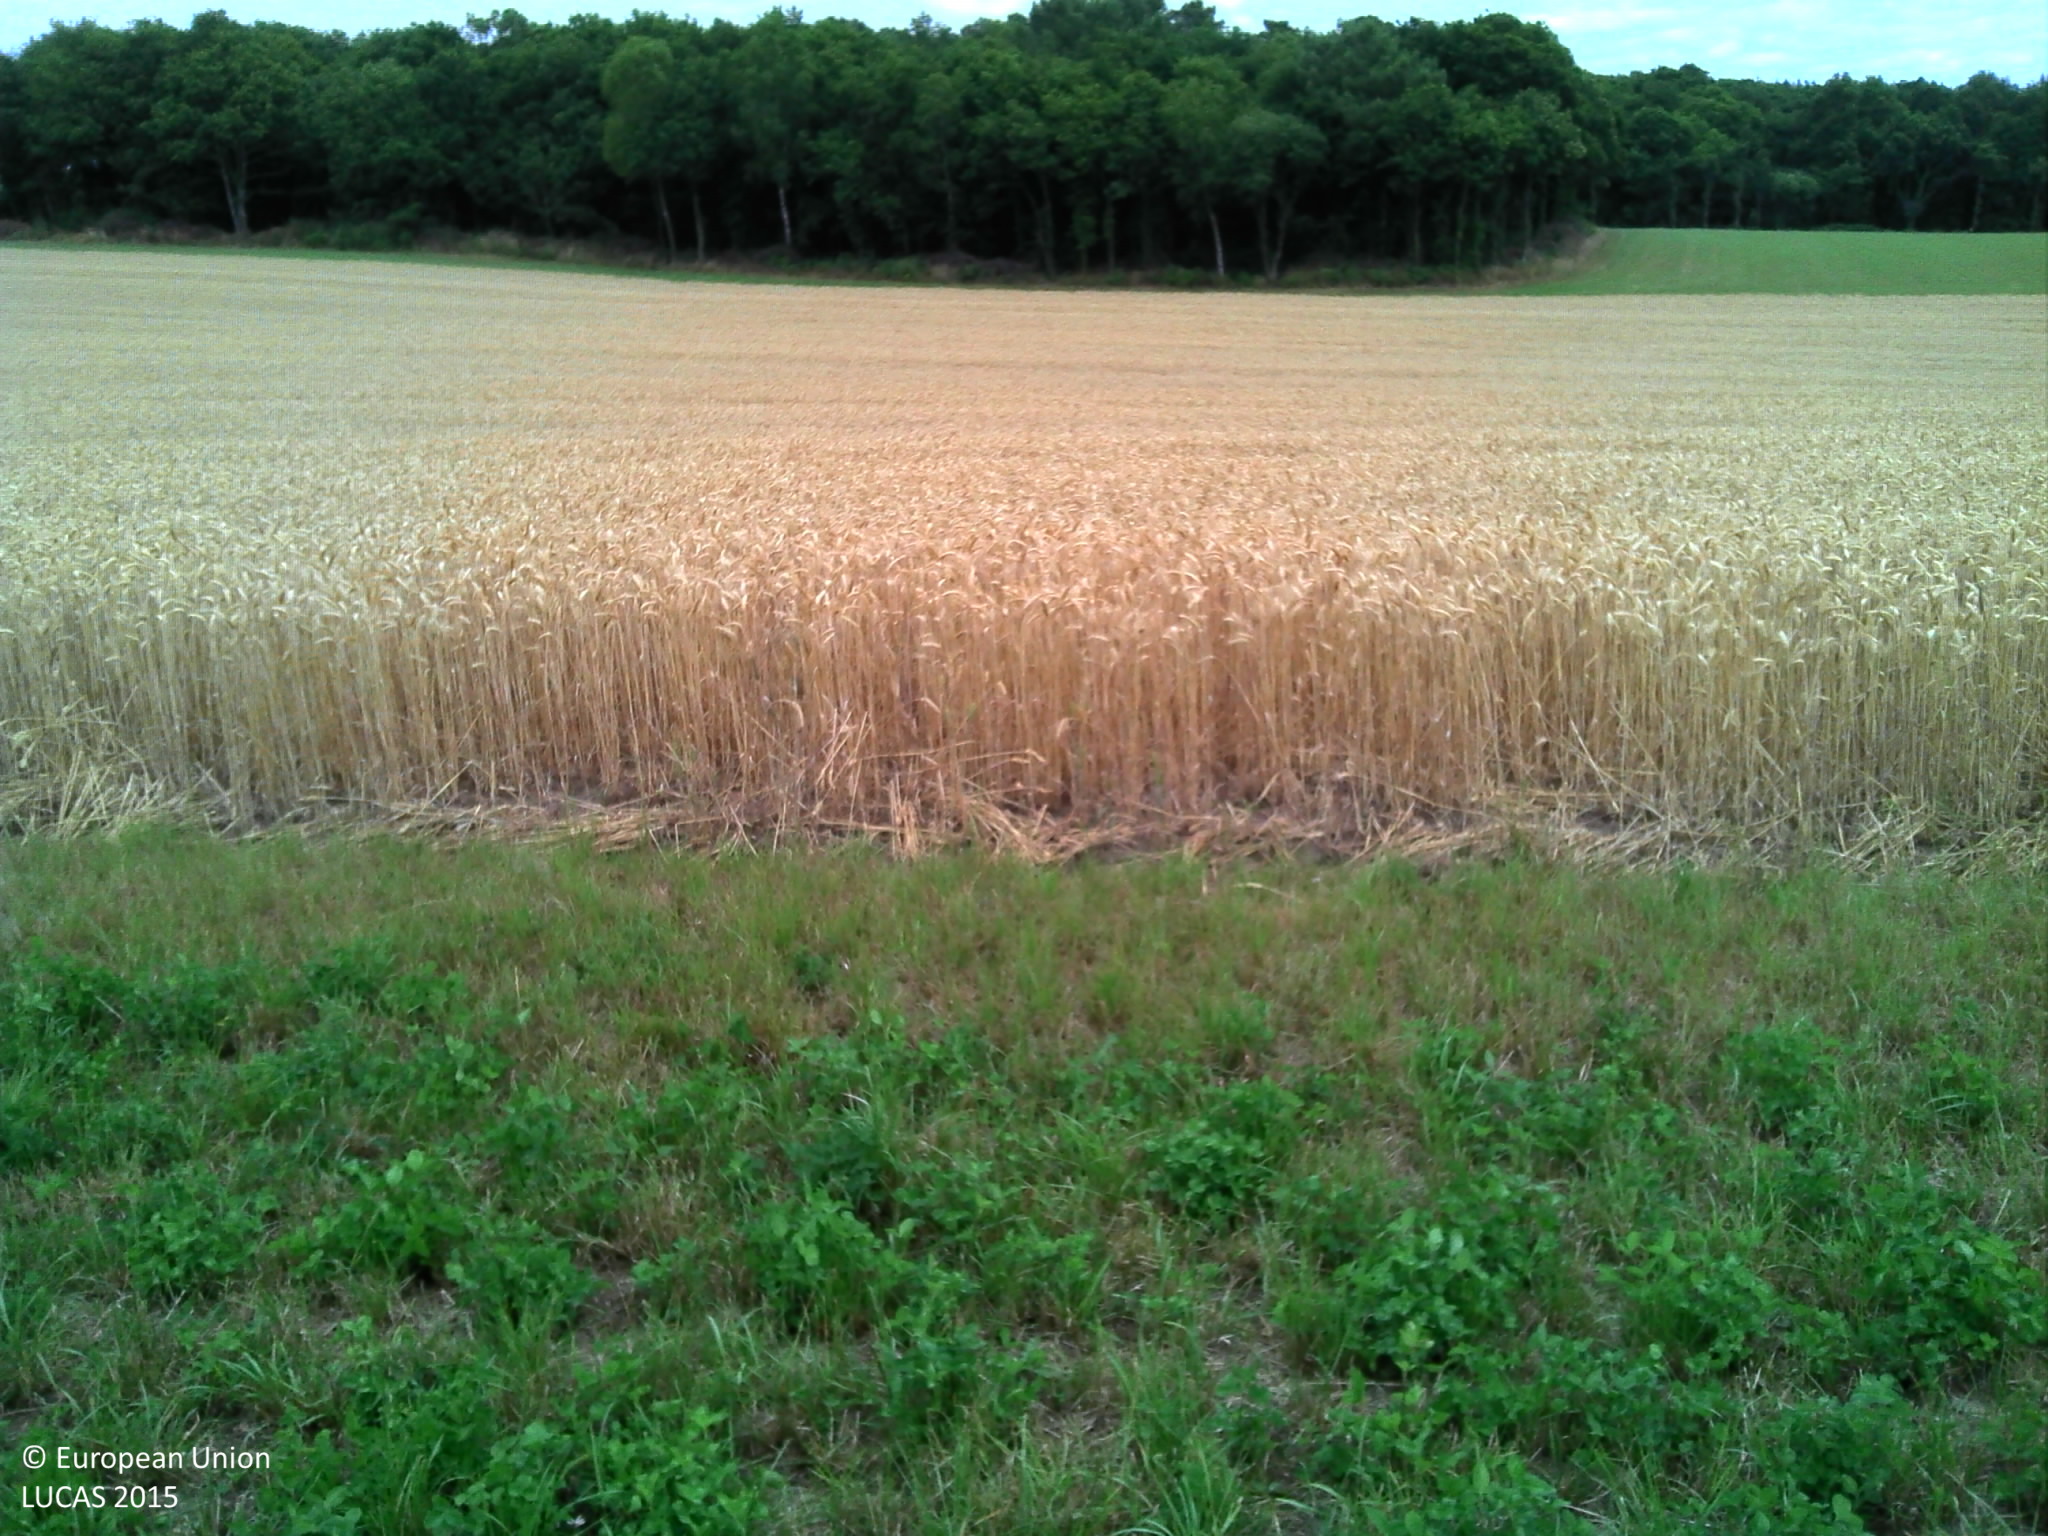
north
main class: Cropland
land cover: Temporary grasslands
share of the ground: > 75 %
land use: Agriculture (excluding fallow land and kitchen gardens)
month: July
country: FR
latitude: 47.8441
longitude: -3.2058
